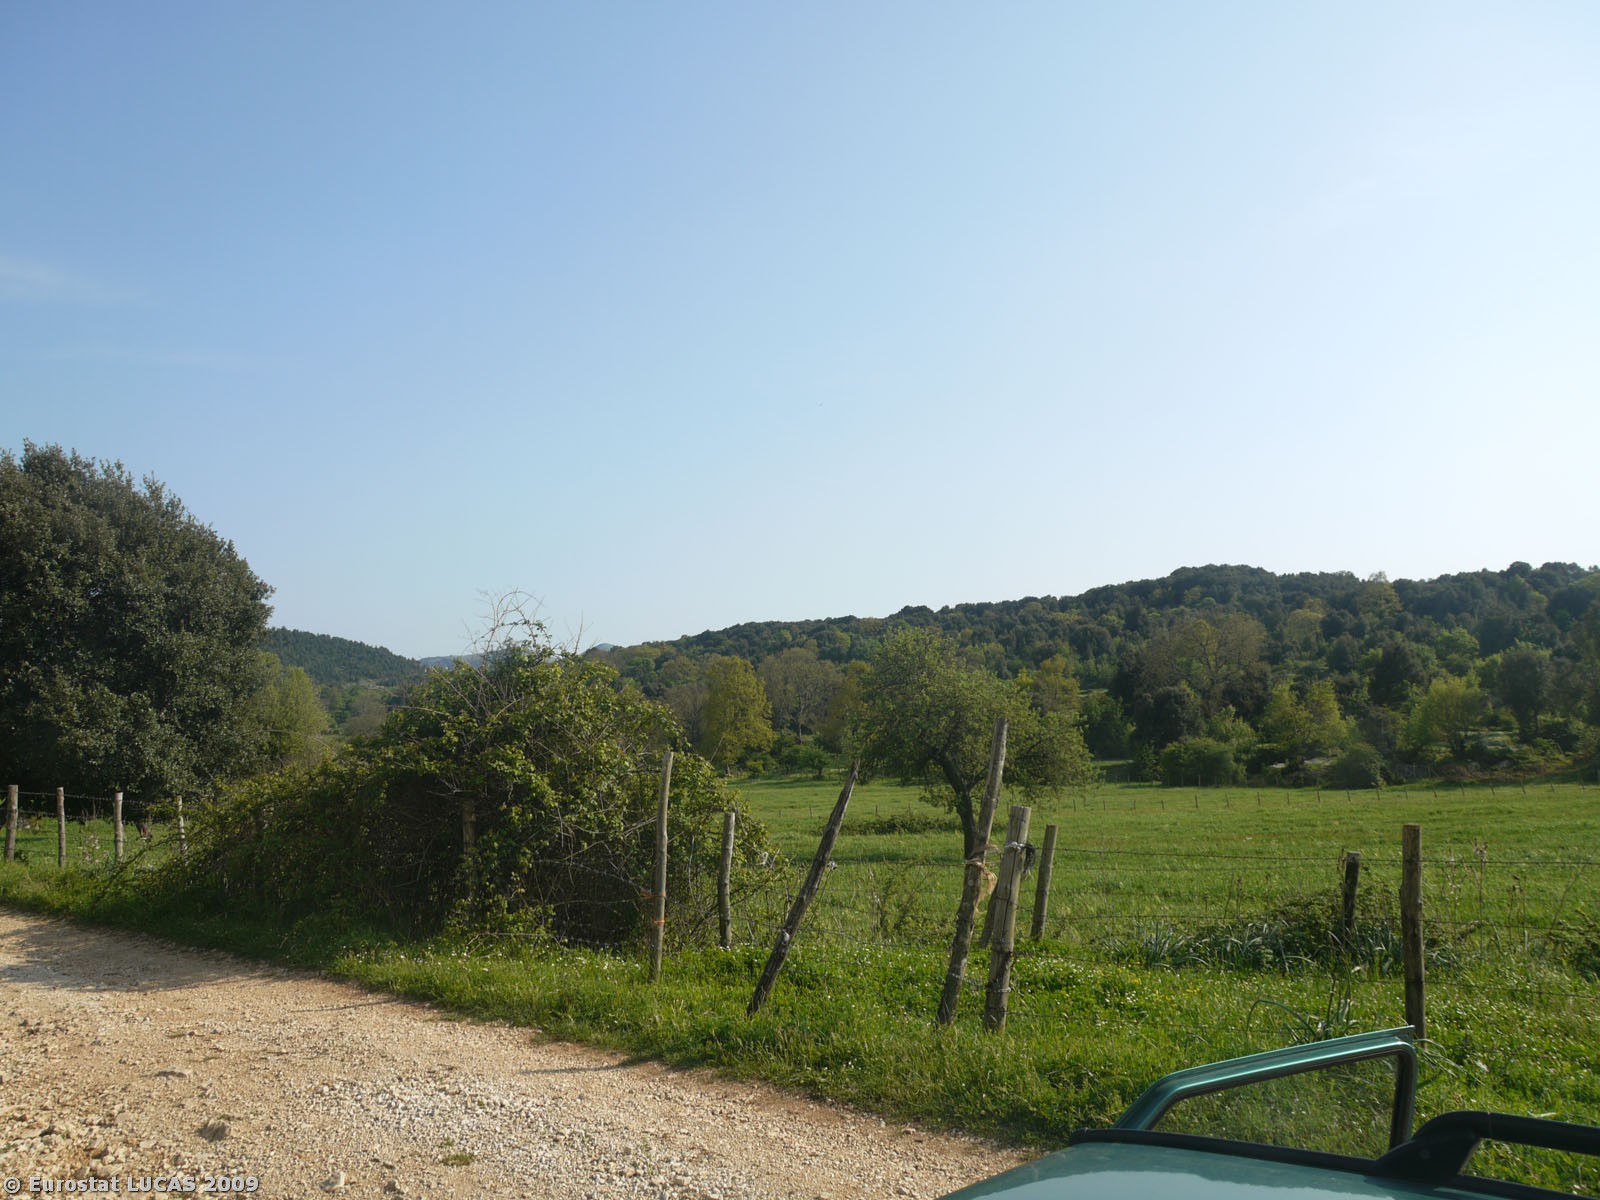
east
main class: Woodland
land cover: Broadleaved woodland
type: broadleaved evergreen forest
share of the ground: > 75 %
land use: Agriculture (excluding fallow land and kitchen gardens)
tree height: > 5 m
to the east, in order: Broadleaved woodland; Grassland with sparse tree/shrub cover; Broadleaved woodland
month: May
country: IT
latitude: 41.4444
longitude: 13.2548
